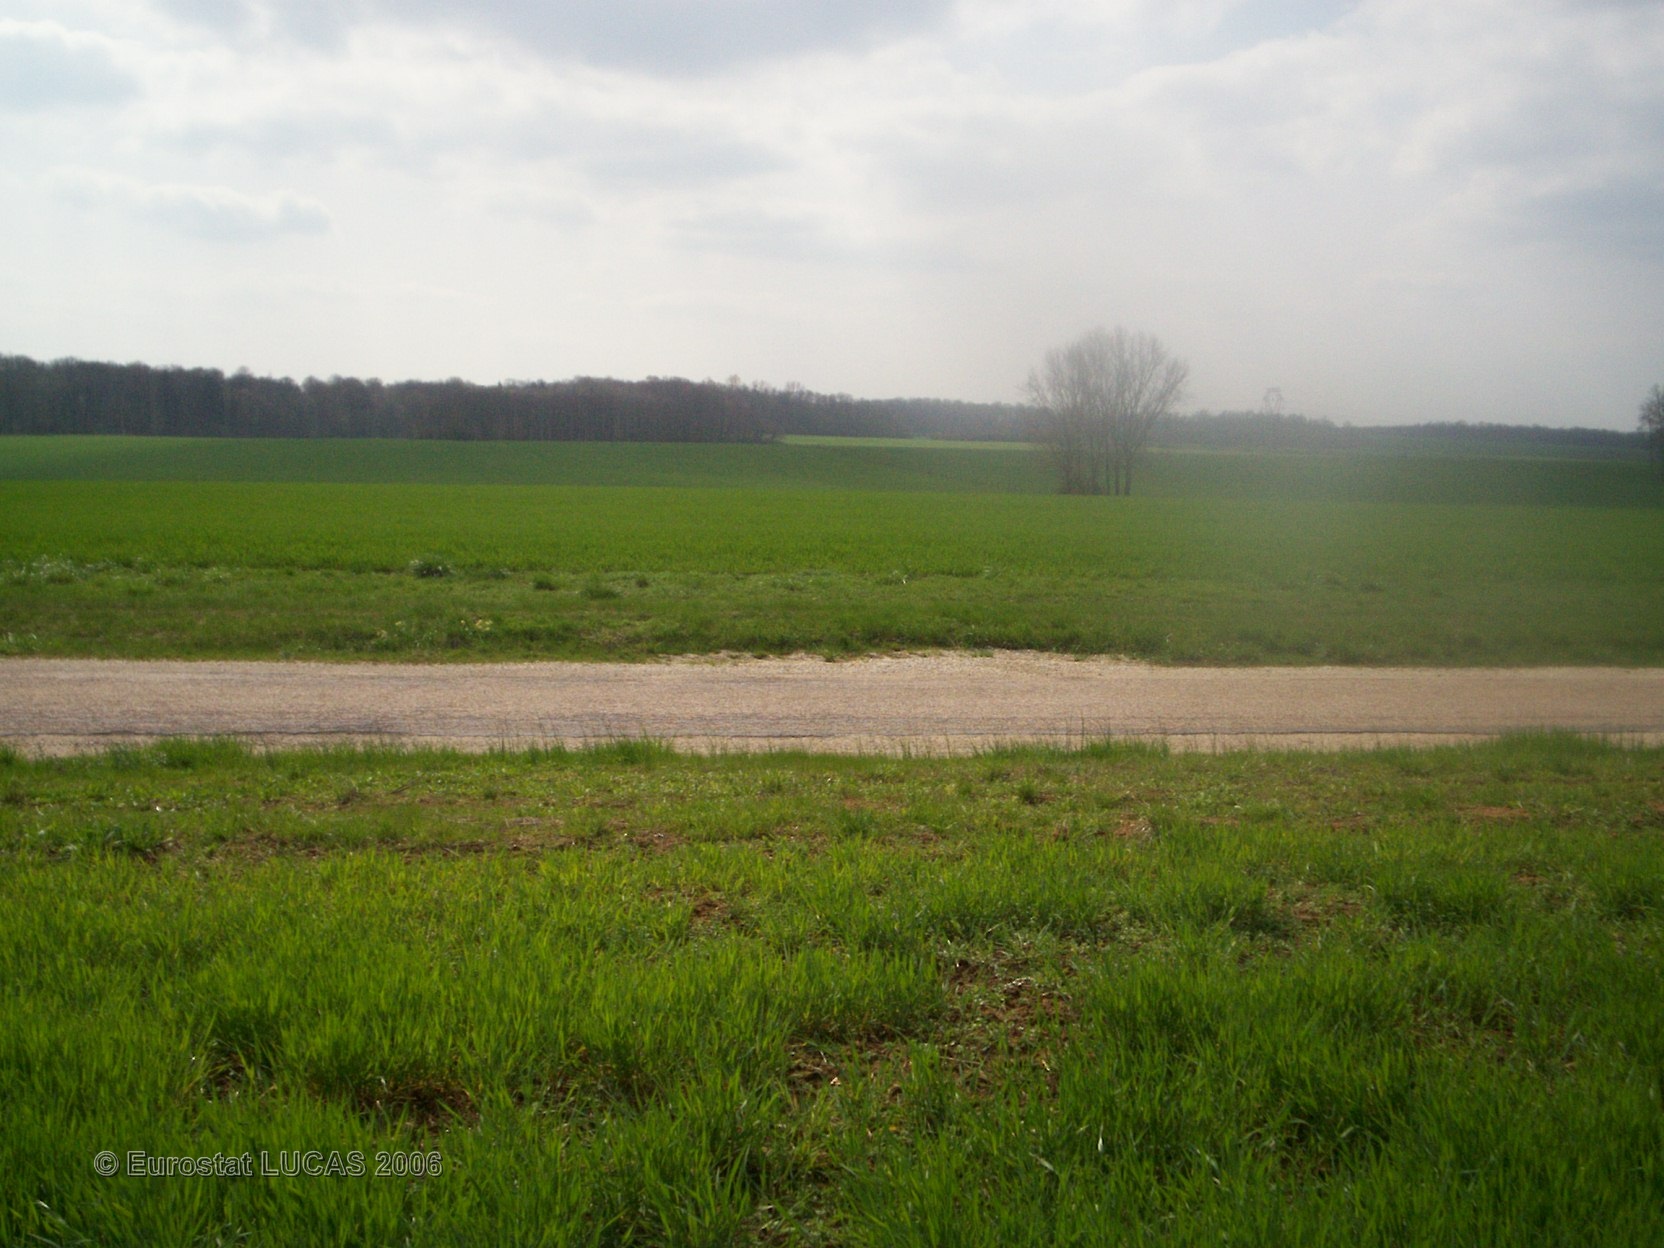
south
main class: Cropland
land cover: Barley
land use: Agriculture (excluding fallow land and kitchen gardens)
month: April
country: FR
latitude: 48.8383
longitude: 5.1616
